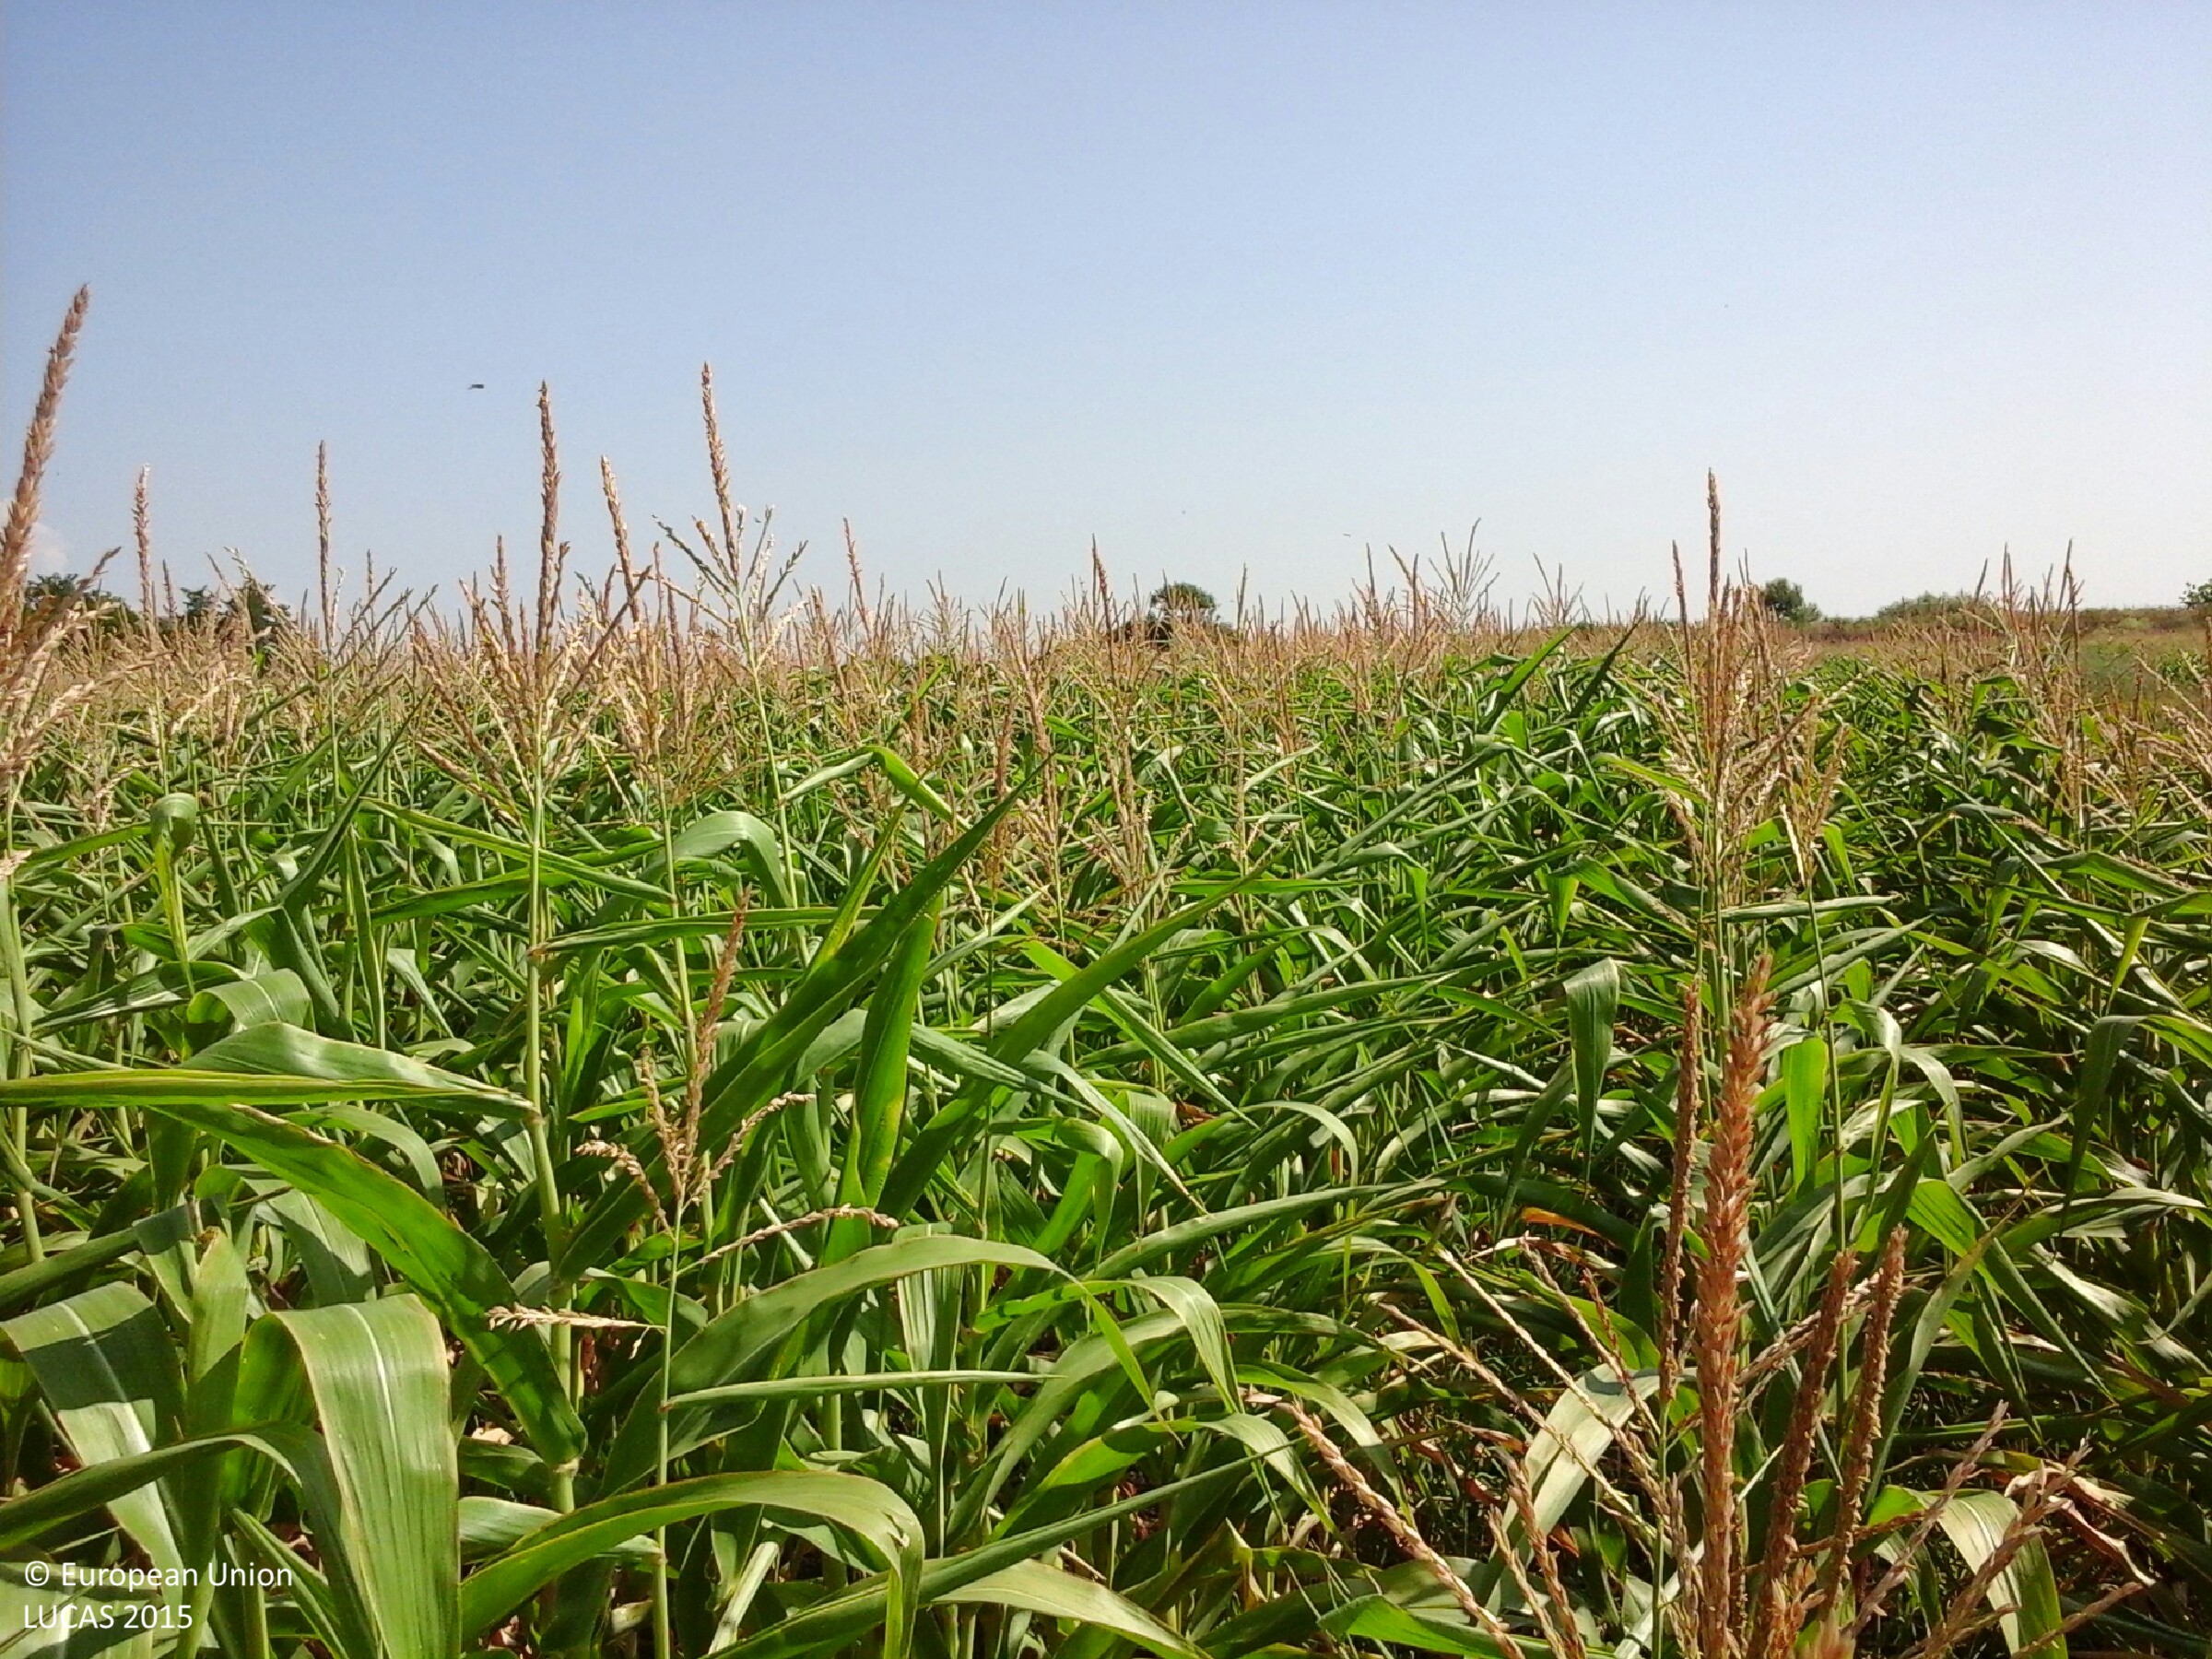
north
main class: Cropland
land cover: Maize
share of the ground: > 75 %
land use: Agriculture (excluding fallow land and kitchen gardens)
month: July
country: HU
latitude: 47.6422
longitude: 20.5614
